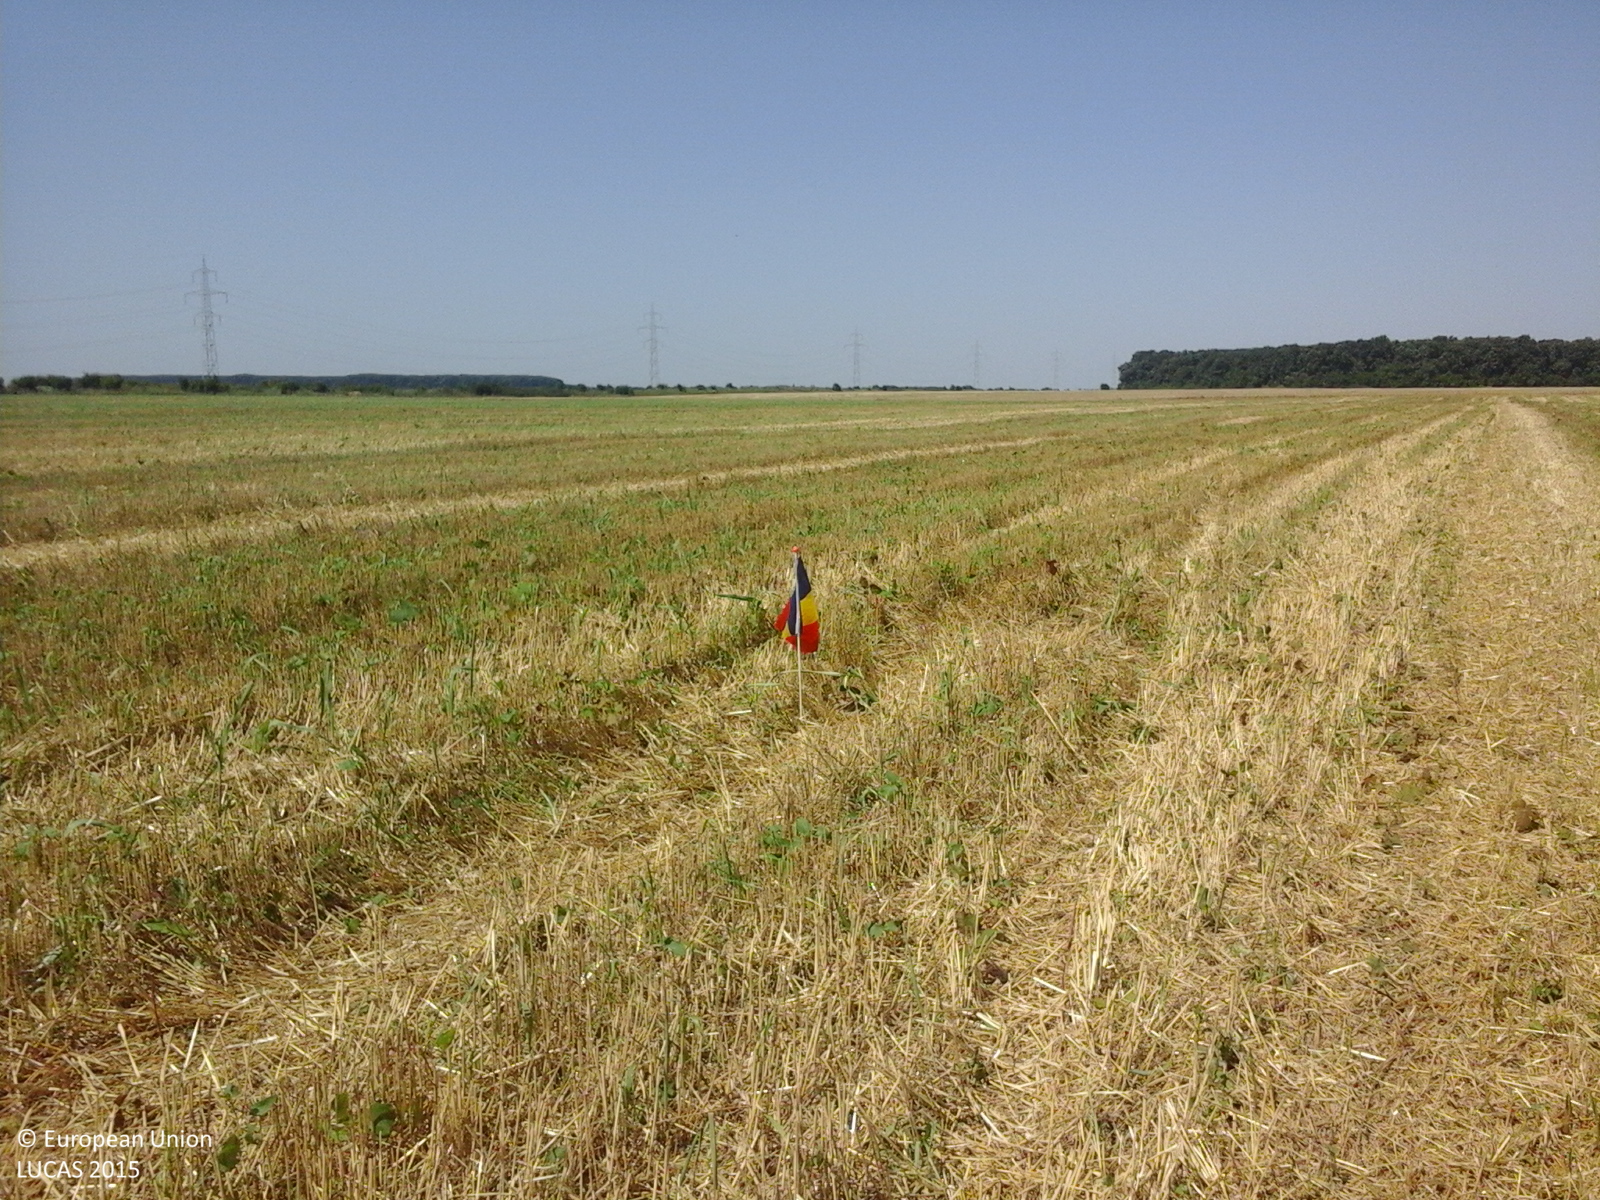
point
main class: Cropland
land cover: Common wheat
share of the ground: < 10 %
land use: Agriculture (excluding fallow land and kitchen gardens)
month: July
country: RO
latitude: 44.4051
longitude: 26.4496
